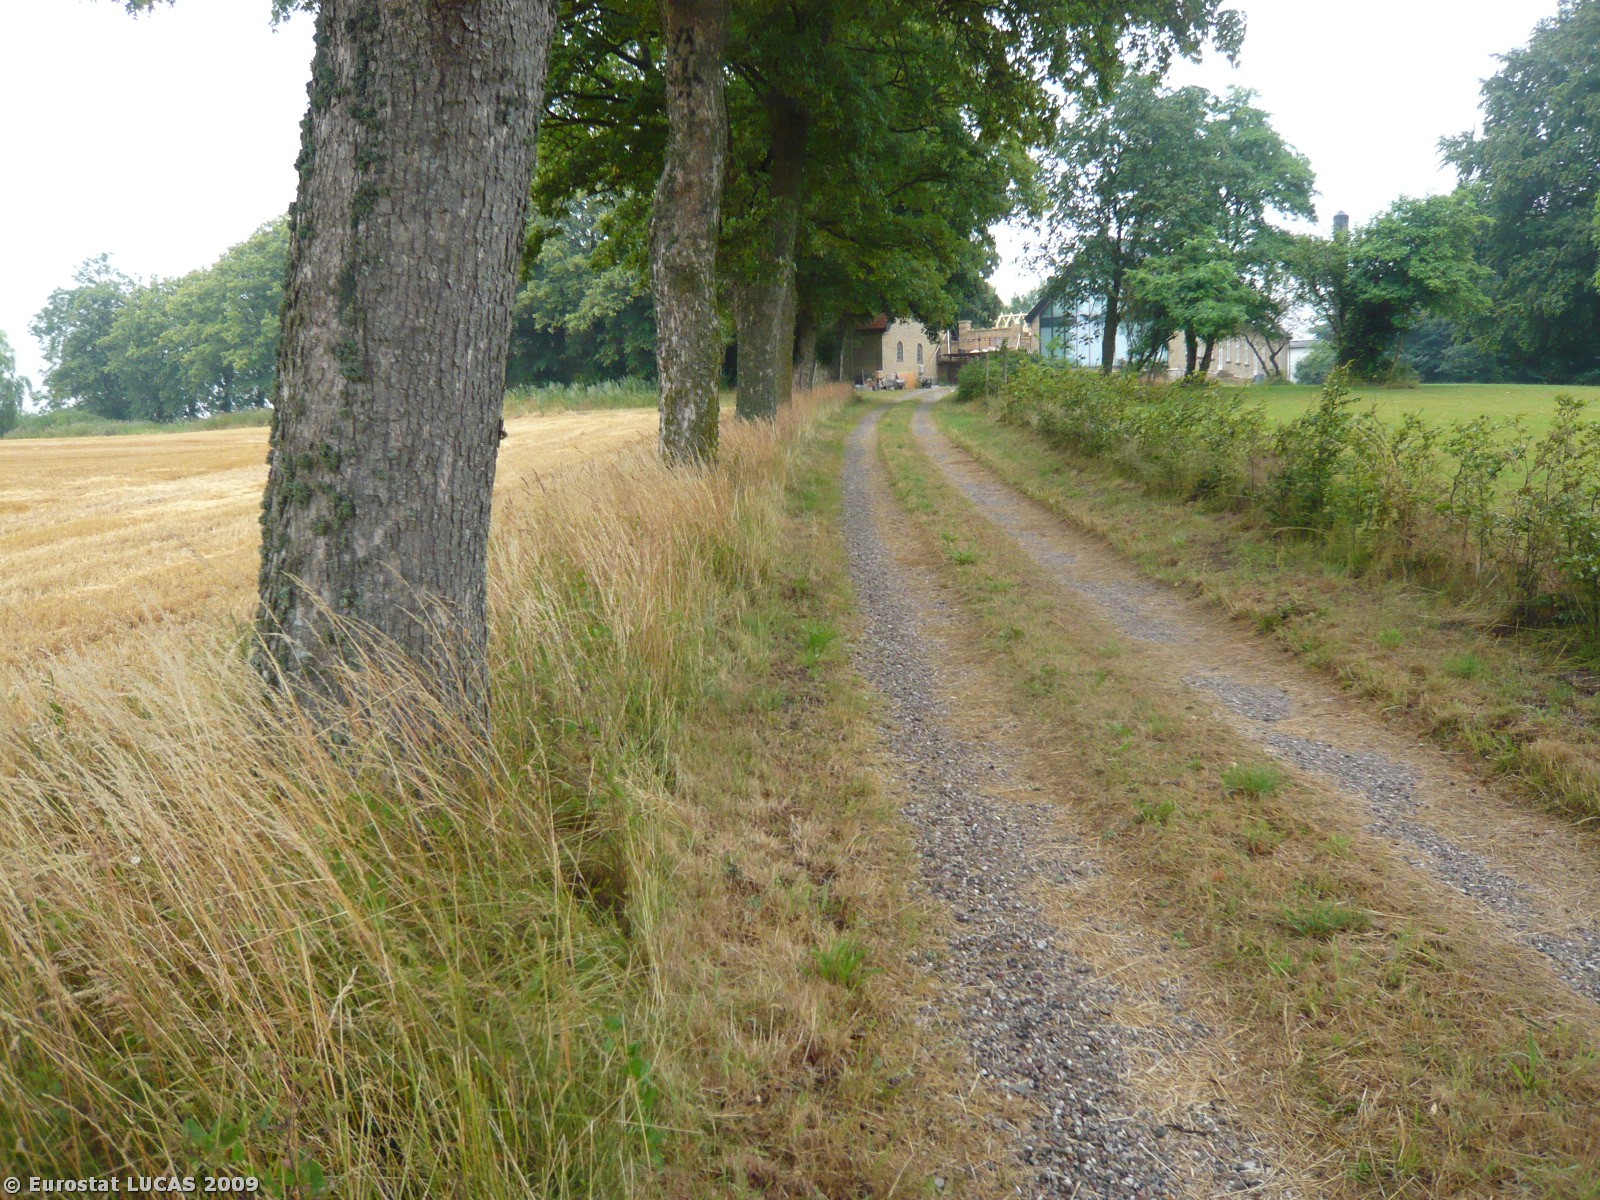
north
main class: Cropland
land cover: Common wheat
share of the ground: > 75 %
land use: Agriculture (excluding fallow land and kitchen gardens)
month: July
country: DK
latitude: 55.6016
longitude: 11.6650
